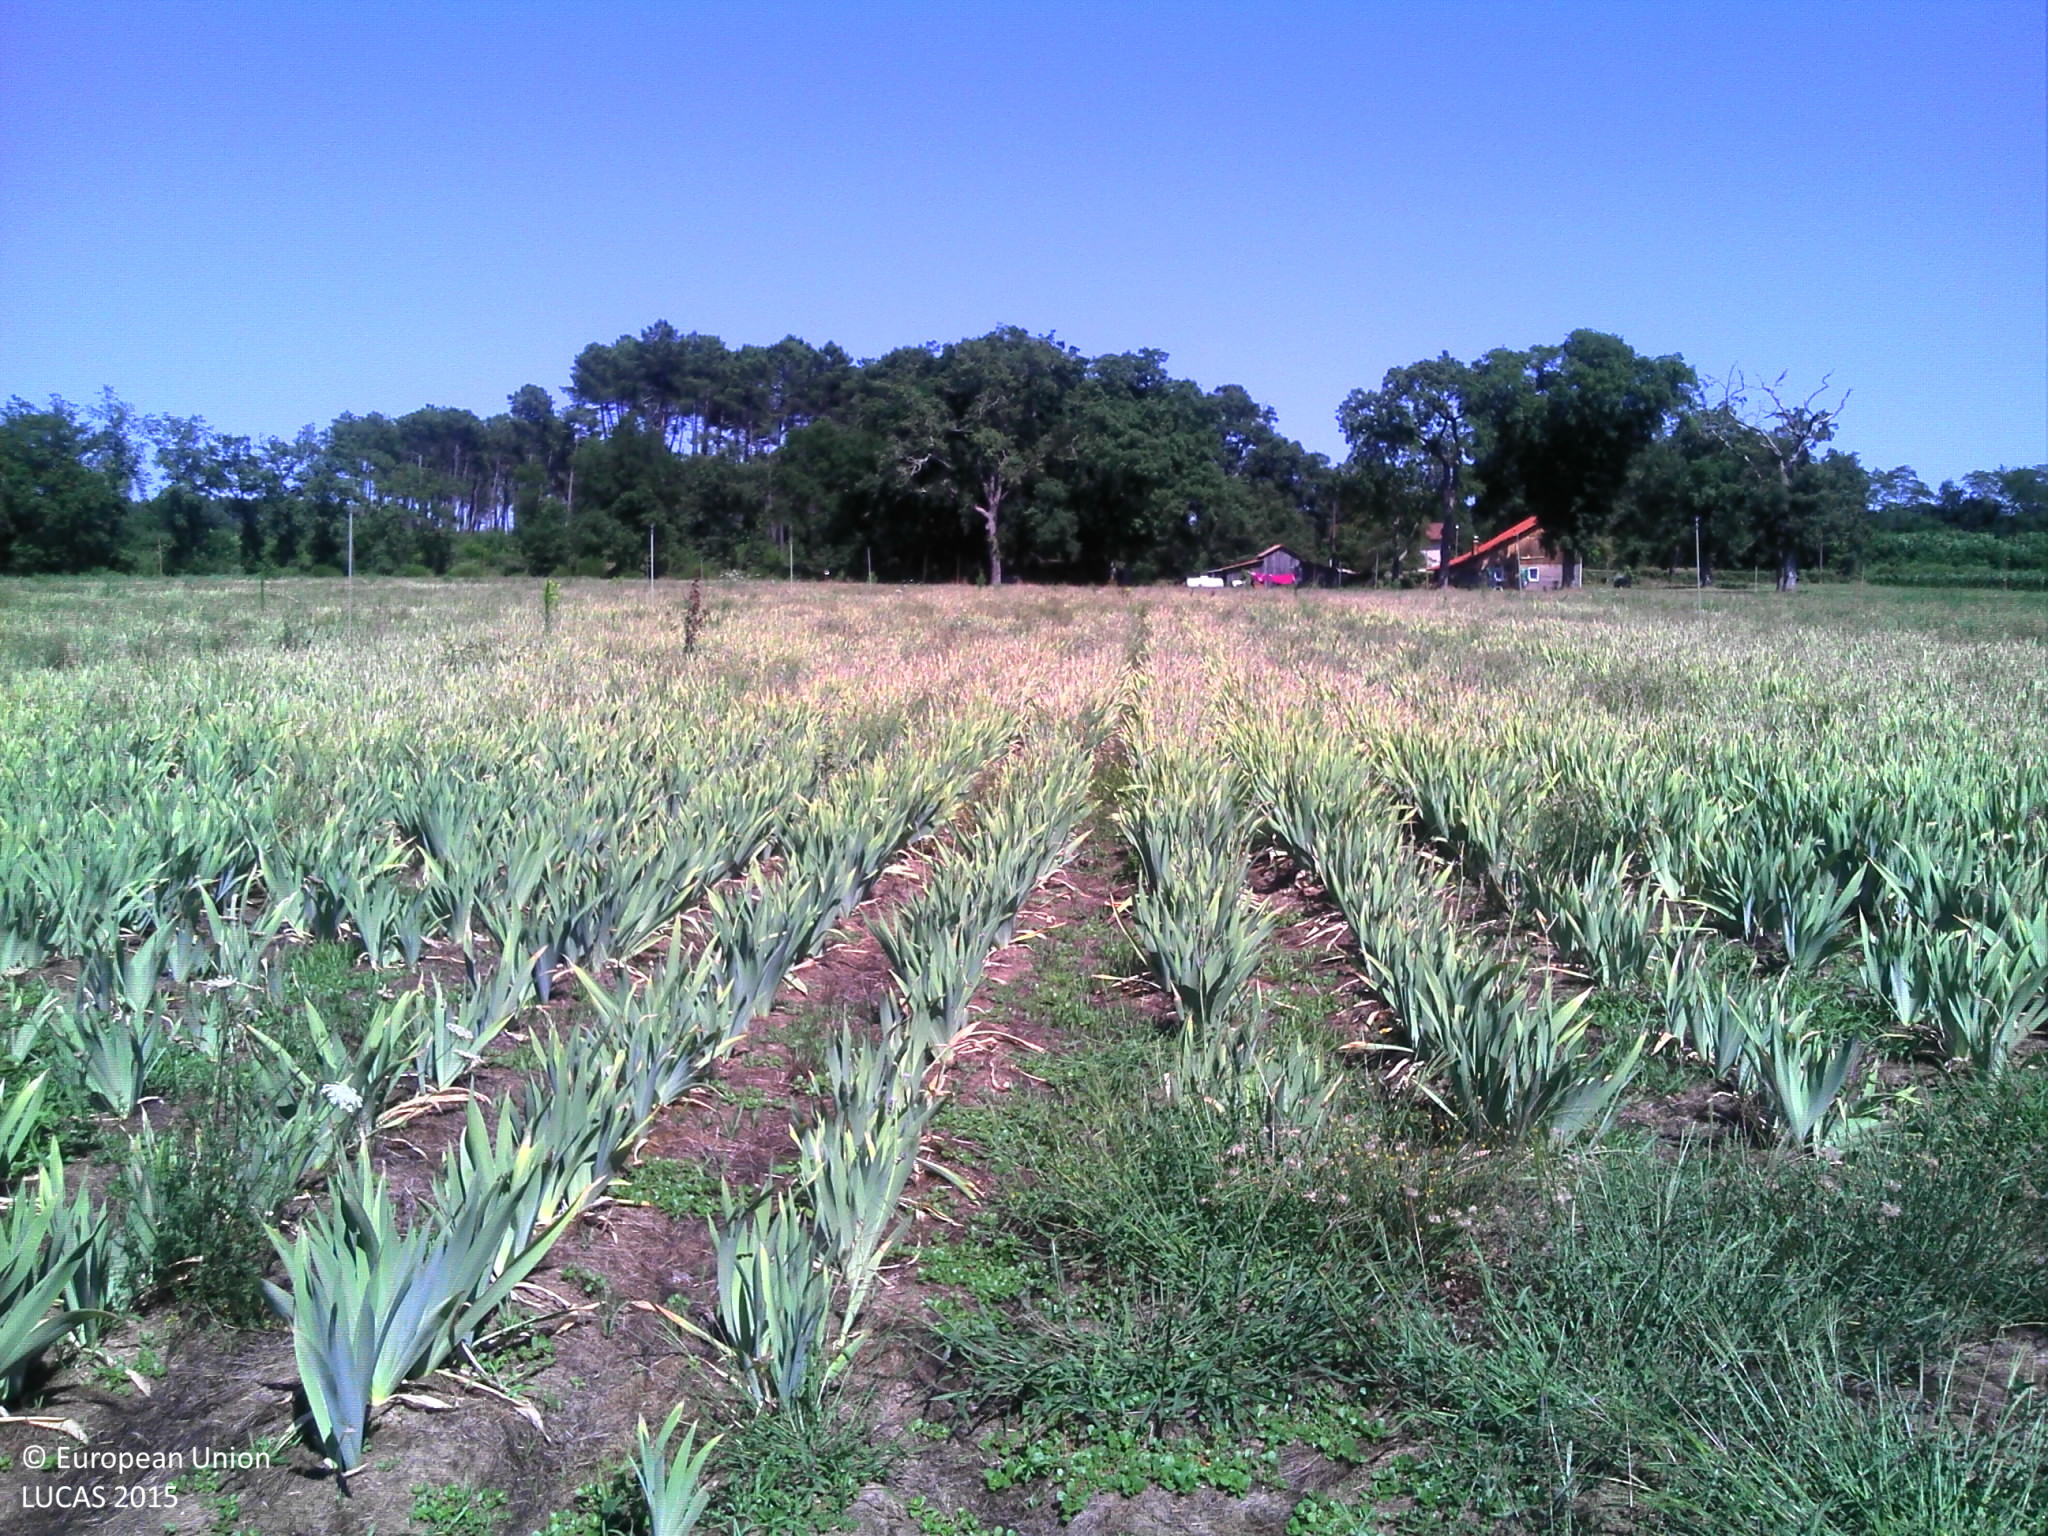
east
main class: Cropland
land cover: Floriculture and ornamental plants
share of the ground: > 75 %
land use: Agriculture (excluding fallow land and kitchen gardens)
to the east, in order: Floriculture and ornamental plants; Broadleaved woodland; Grass margins; Tracks; Broadleaved woodland
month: July
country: FR
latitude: 44.0491
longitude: -0.5349
